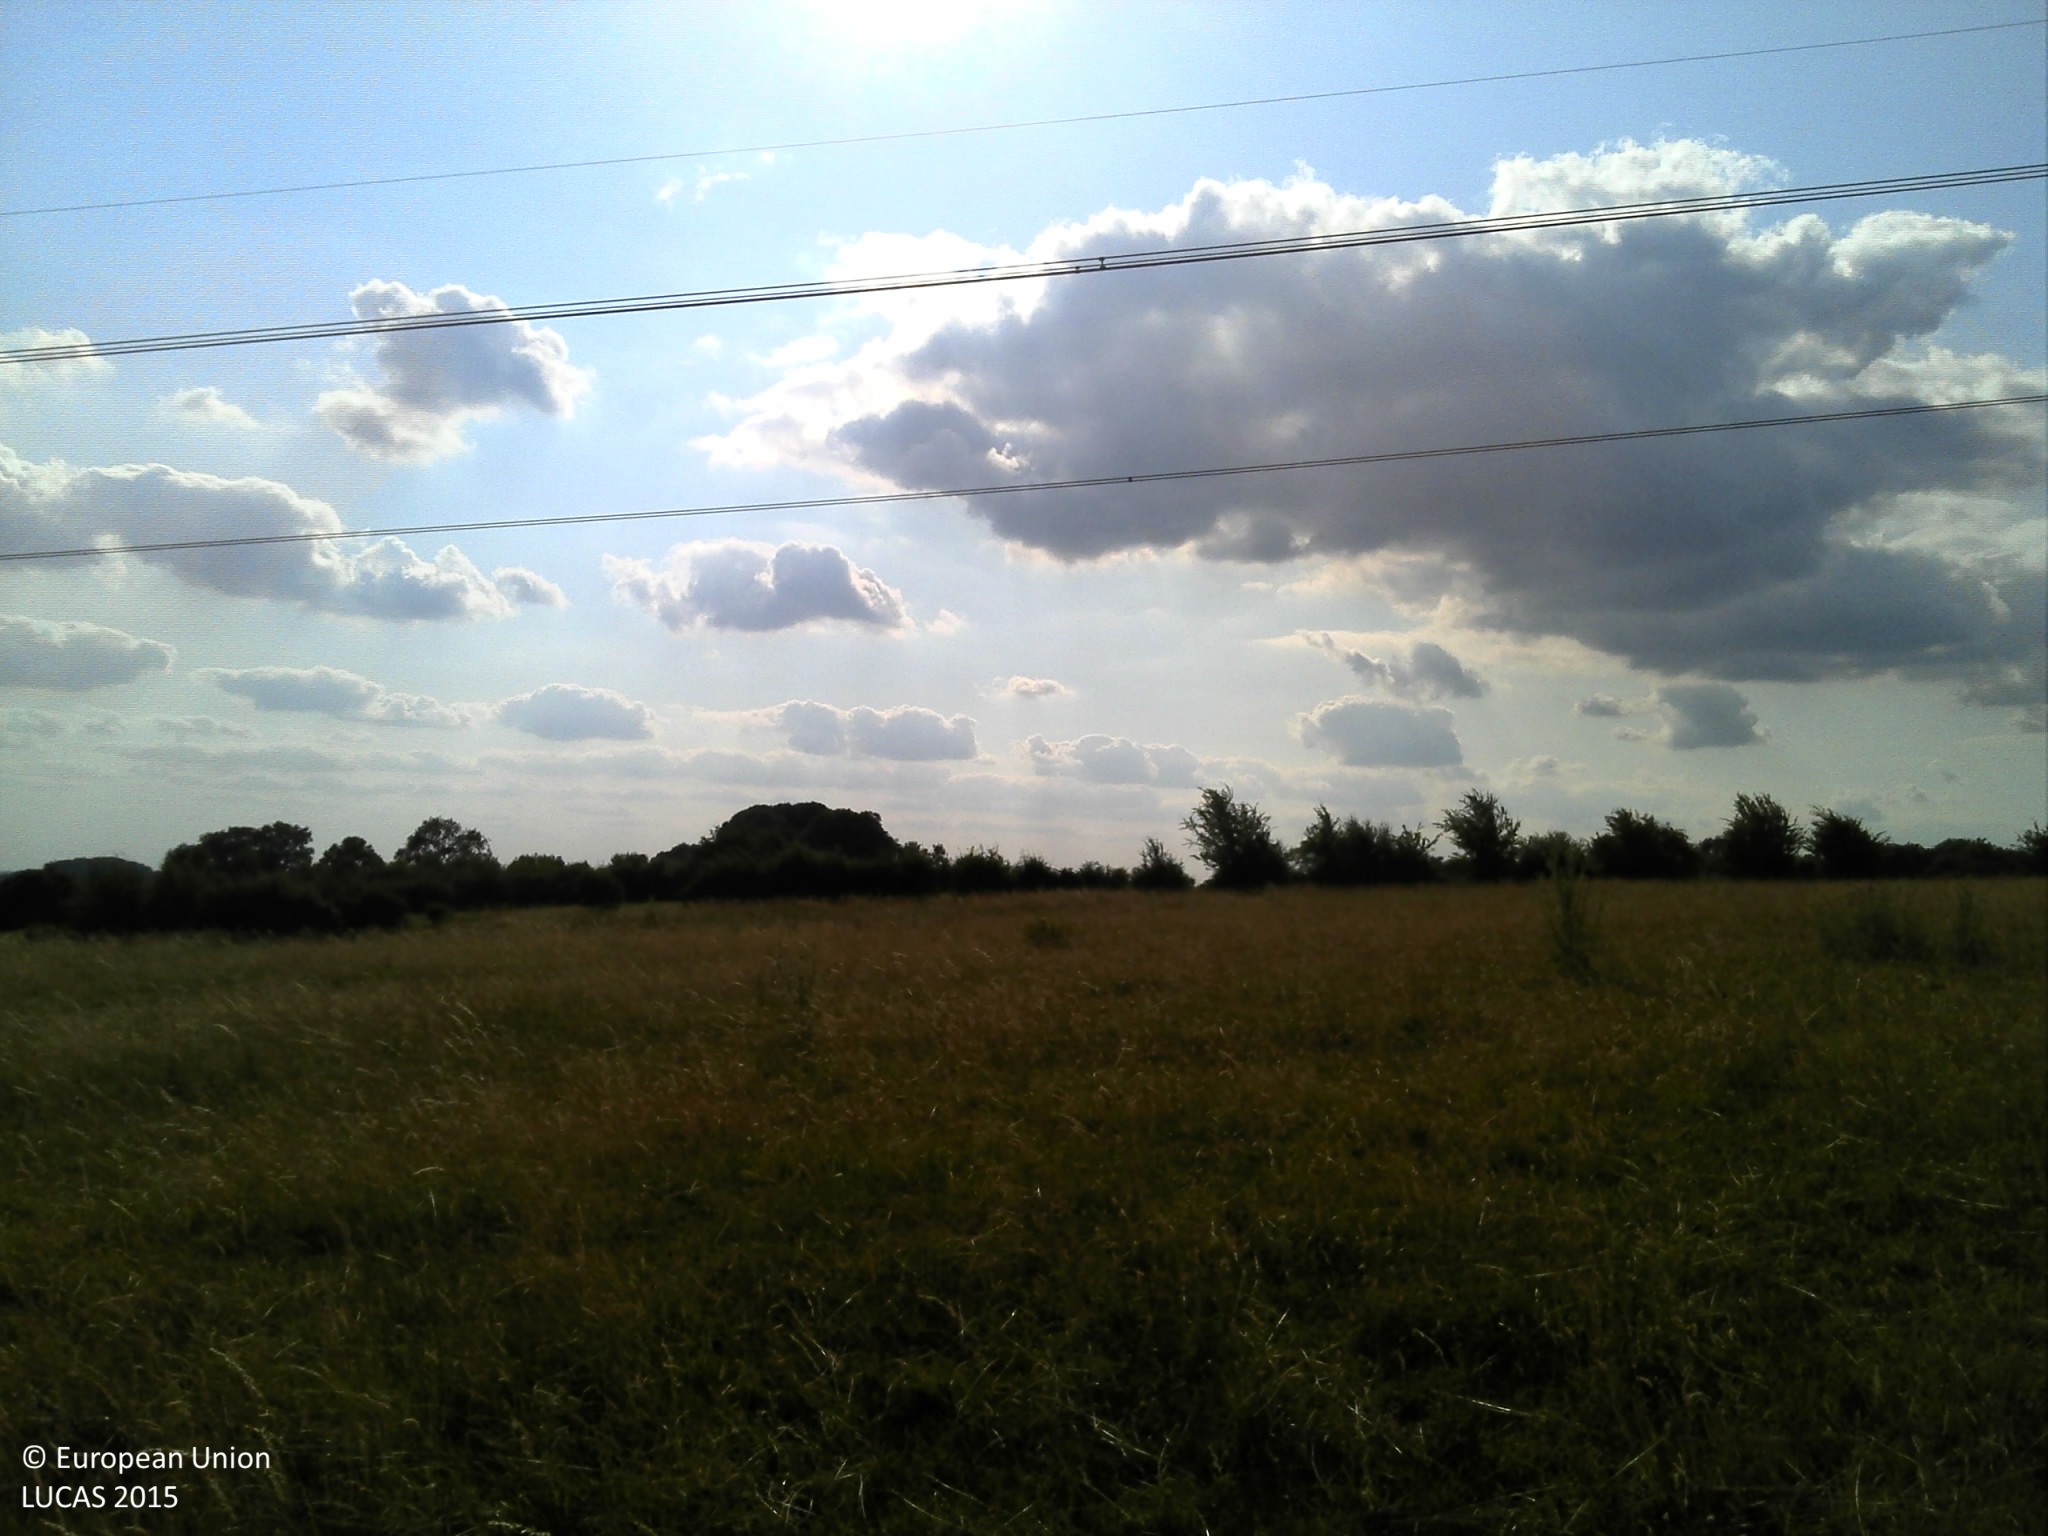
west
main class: Grassland
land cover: Grassland without tree/shrub cover
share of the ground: > 75 %
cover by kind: herbaceous plants 100 %
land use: Agriculture (excluding fallow land and kitchen gardens)
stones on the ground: < 10 %
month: July
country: FR
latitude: 49.6369
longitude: 4.4990
